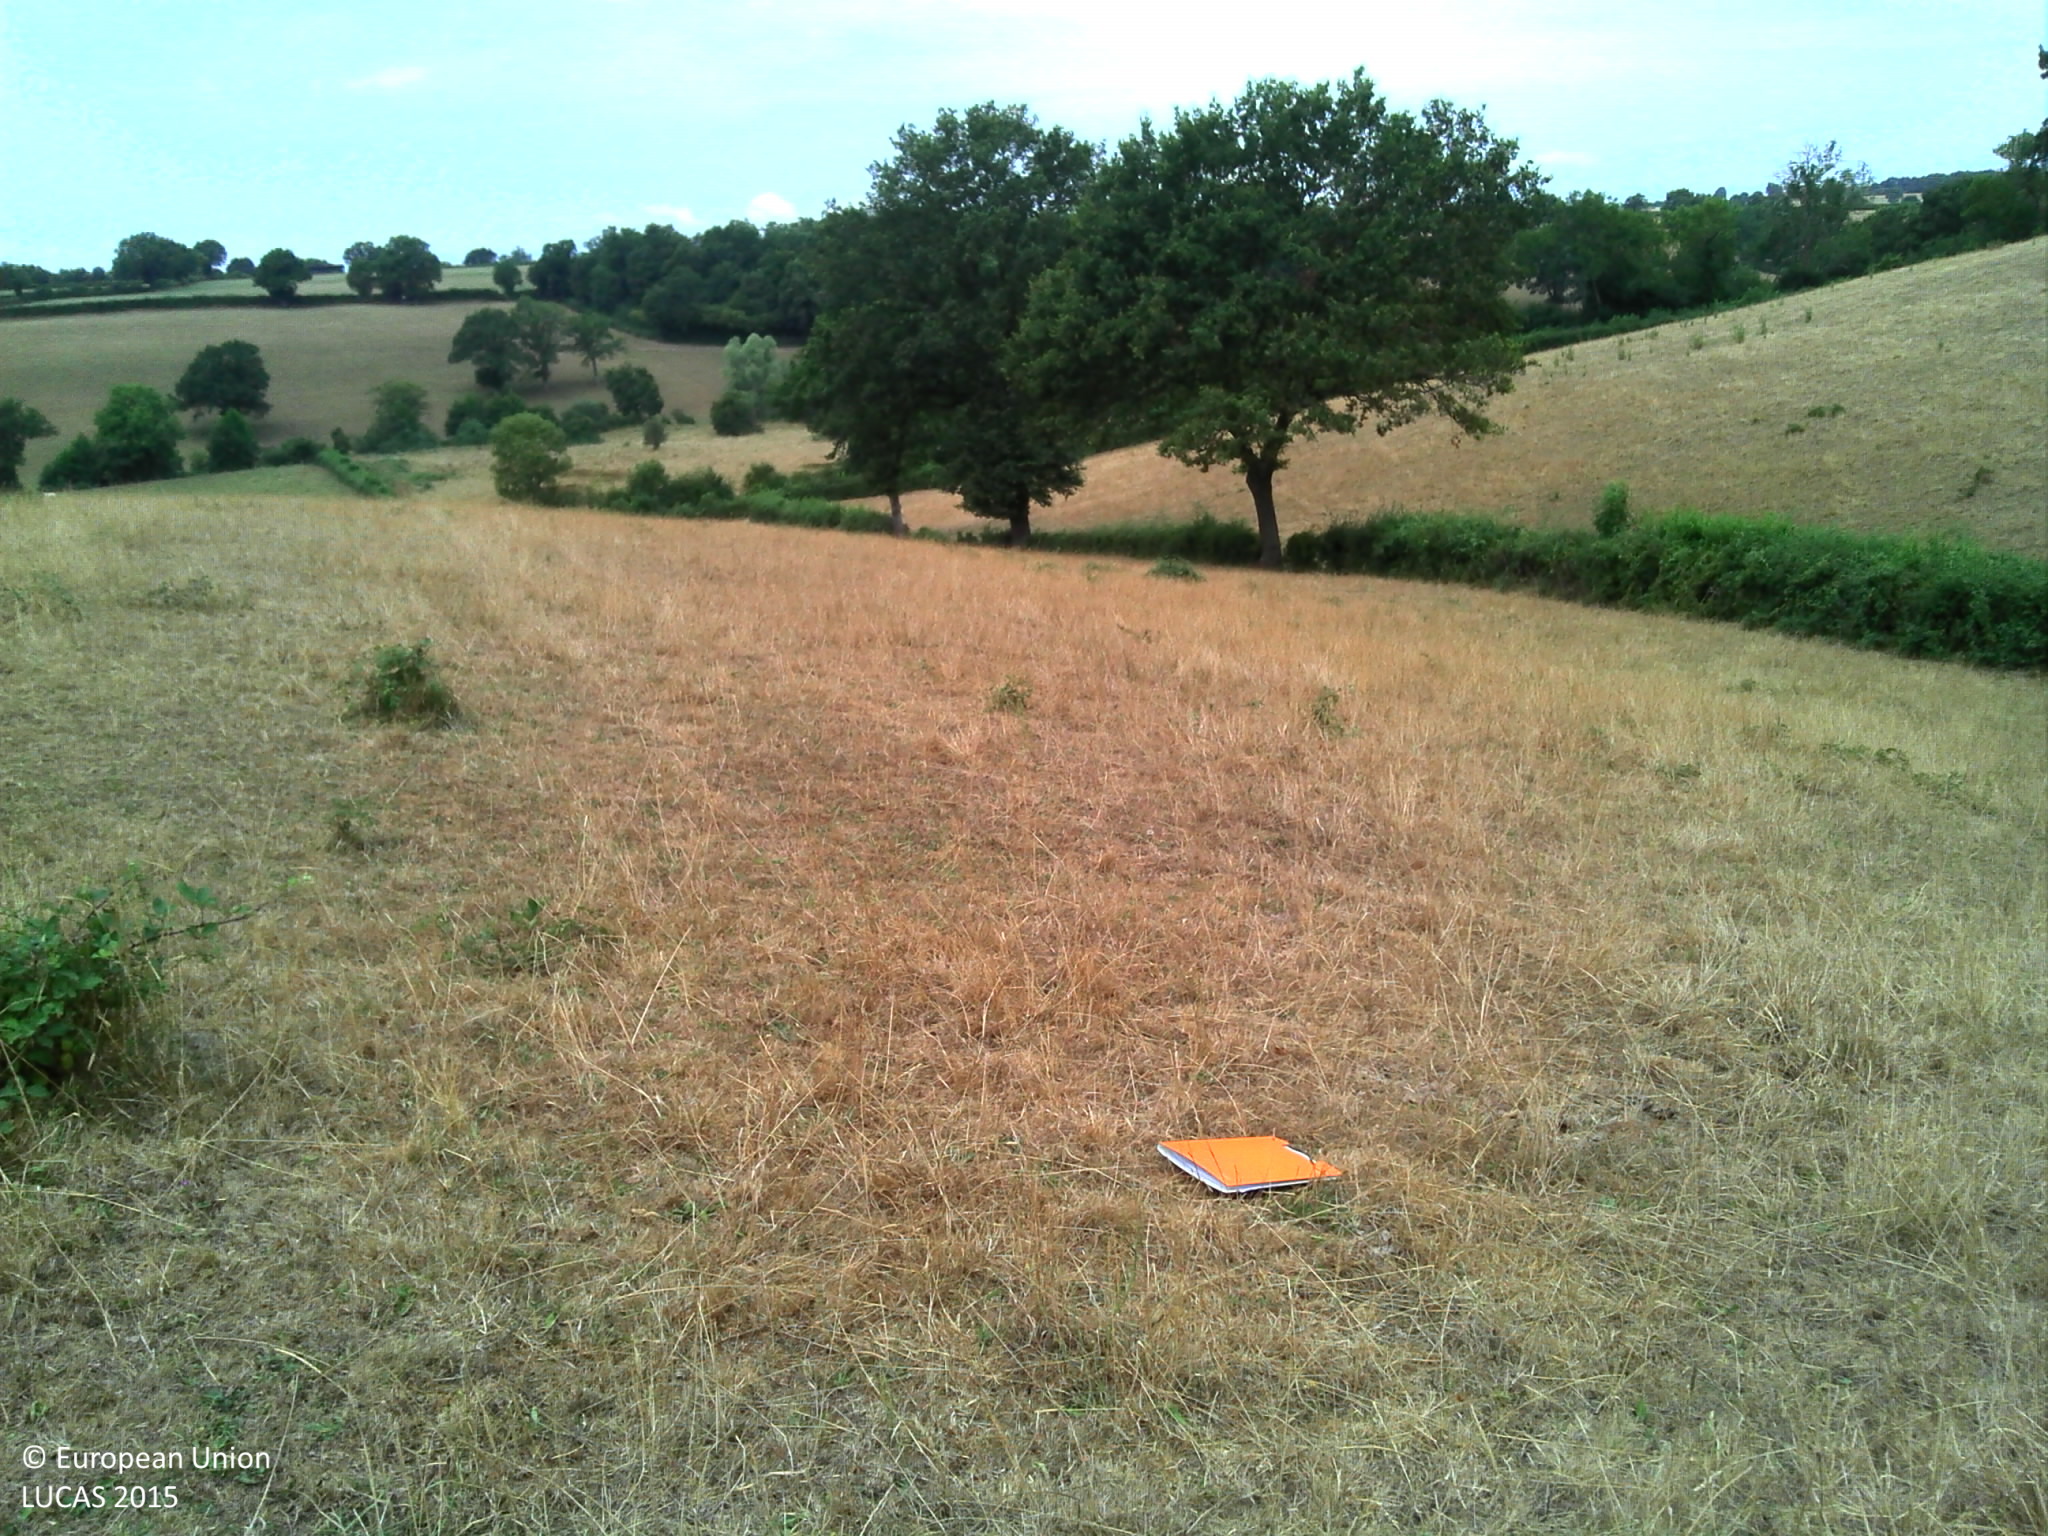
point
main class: Grassland
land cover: Grassland without tree/shrub cover
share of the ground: > 75 %
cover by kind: herbaceous plants 100 %
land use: Agriculture (excluding fallow land and kitchen gardens)
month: July
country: FR
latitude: 46.6268
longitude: 2.9831
